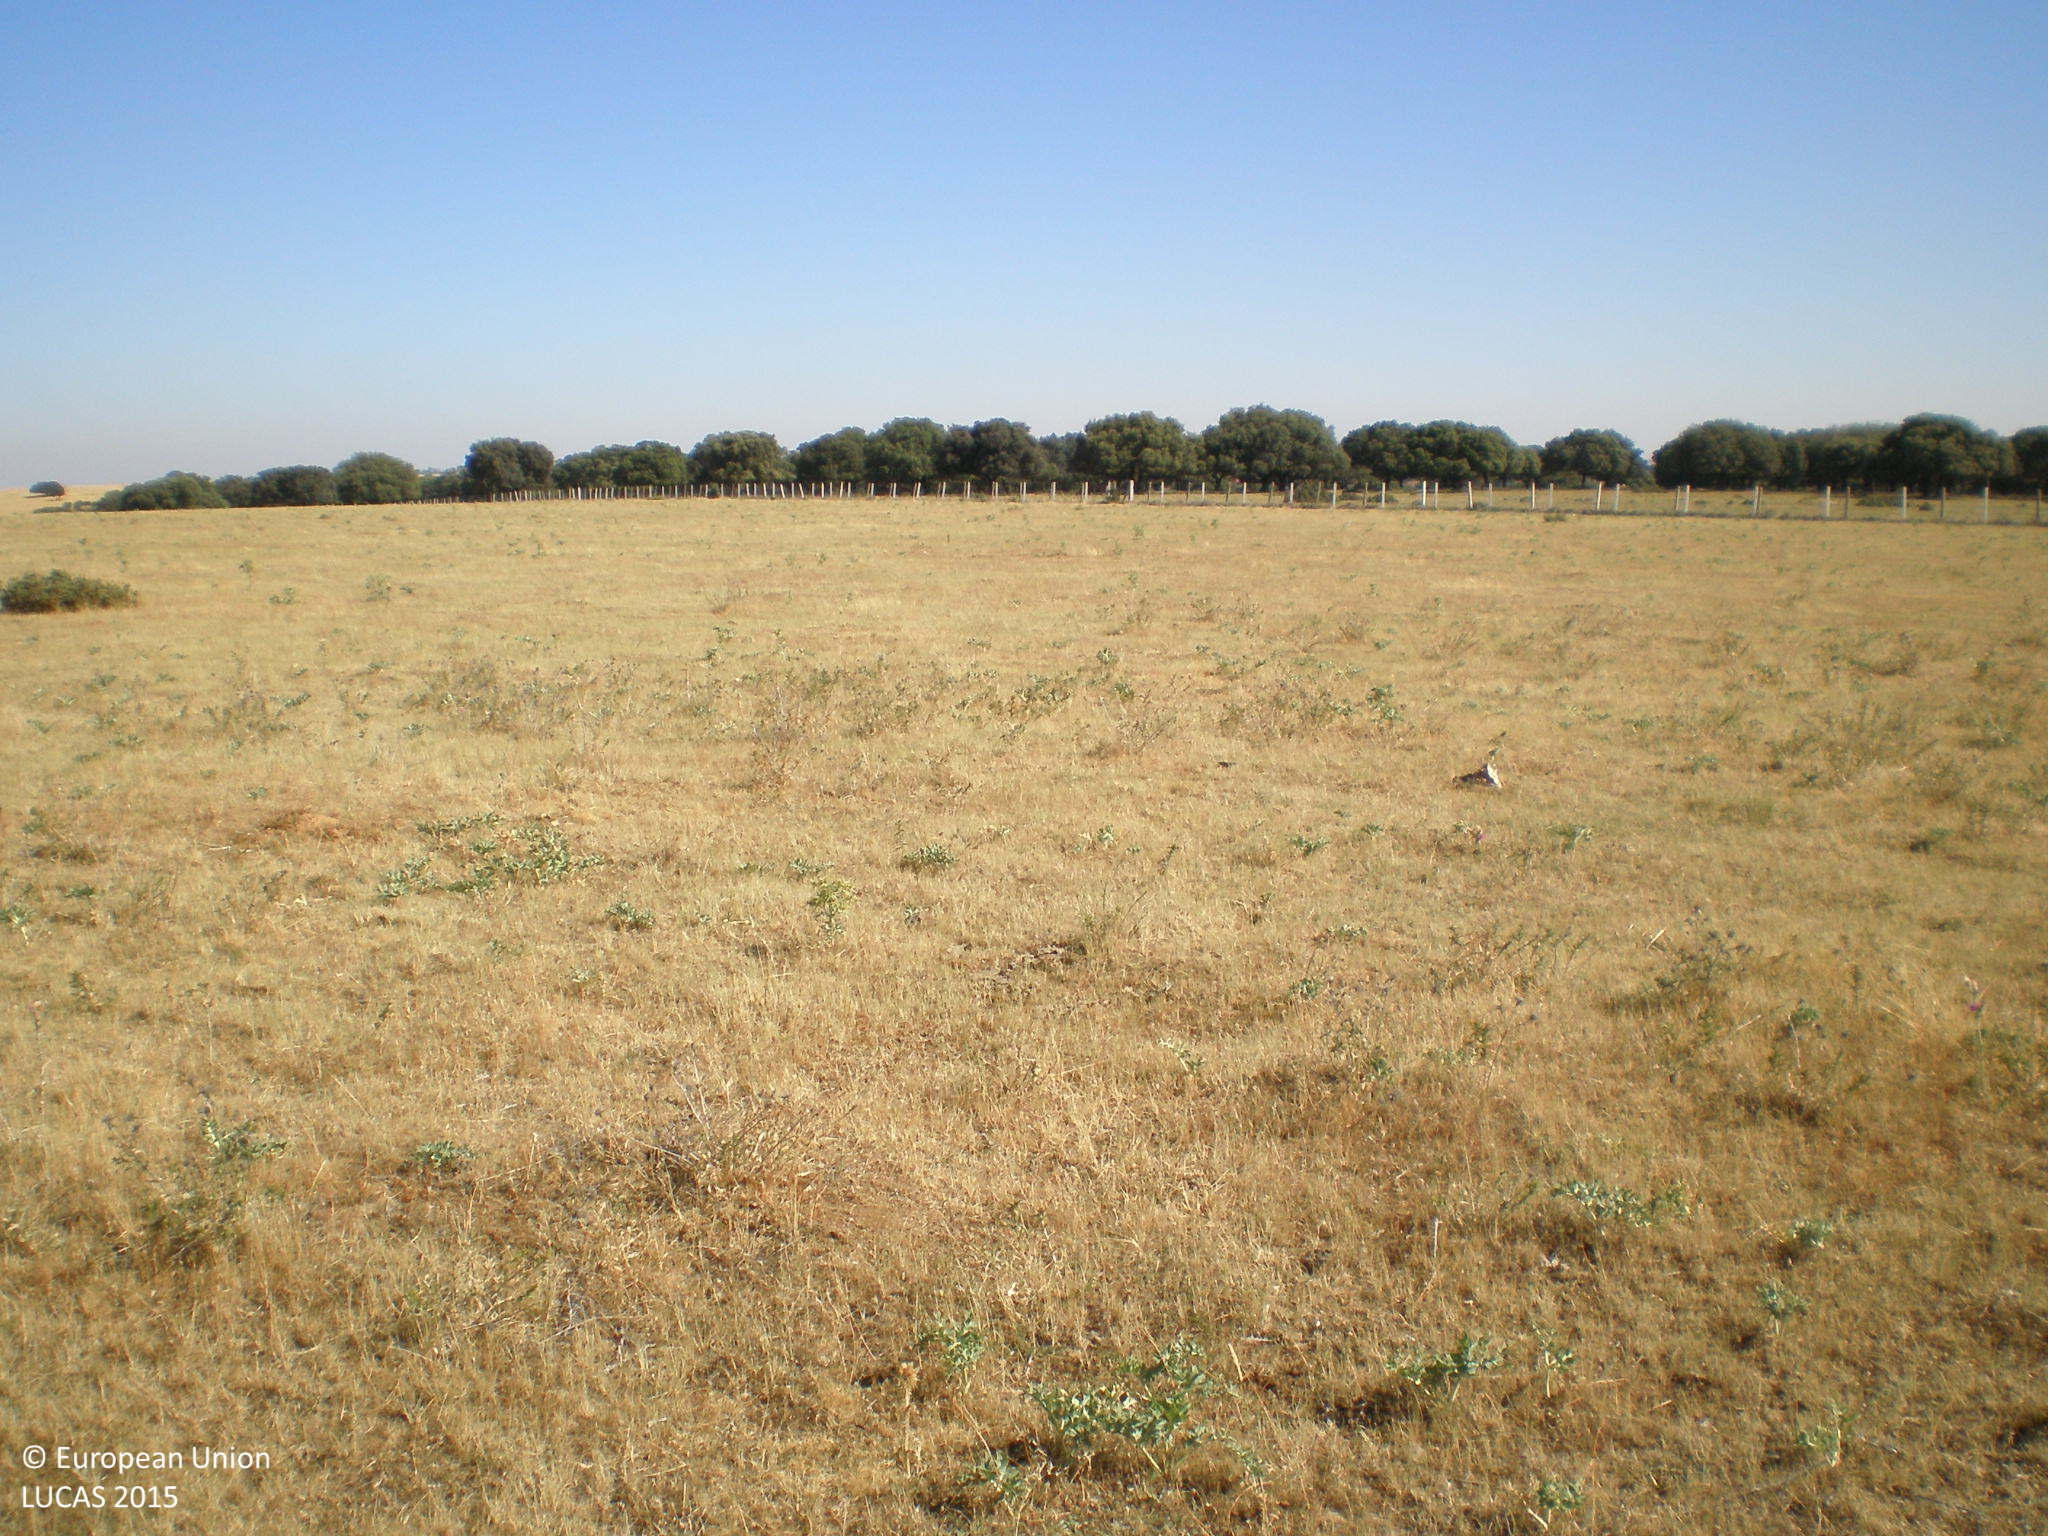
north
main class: Grassland
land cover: Grassland without tree/shrub cover
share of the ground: > 75 %
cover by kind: herbaceous plants 100 %
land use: Agriculture (excluding fallow land and kitchen gardens)
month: June
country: ES
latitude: 40.8125
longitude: -5.7127
